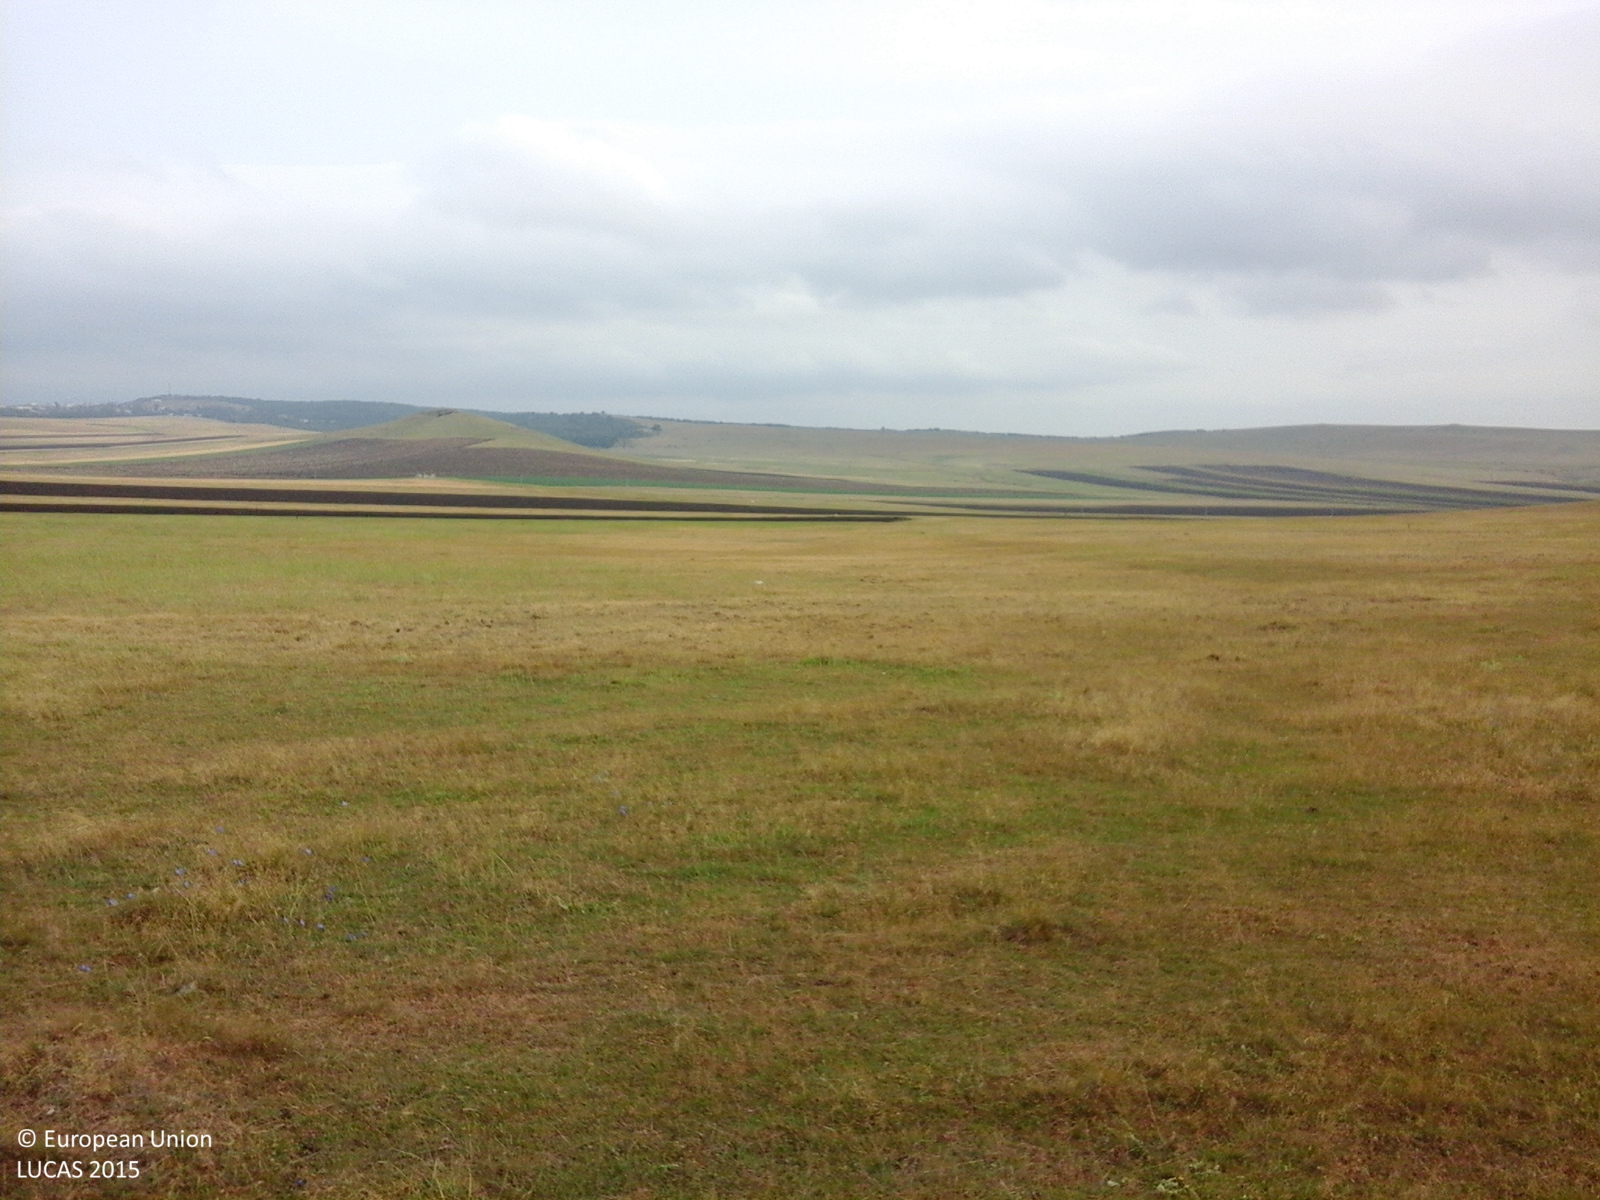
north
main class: Grassland
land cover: Grassland without tree/shrub cover
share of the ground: > 75 %
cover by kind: herbaceous plants 100 %
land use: Agriculture (excluding fallow land and kitchen gardens)
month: August
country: RO
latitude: 44.7588
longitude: 28.5859
